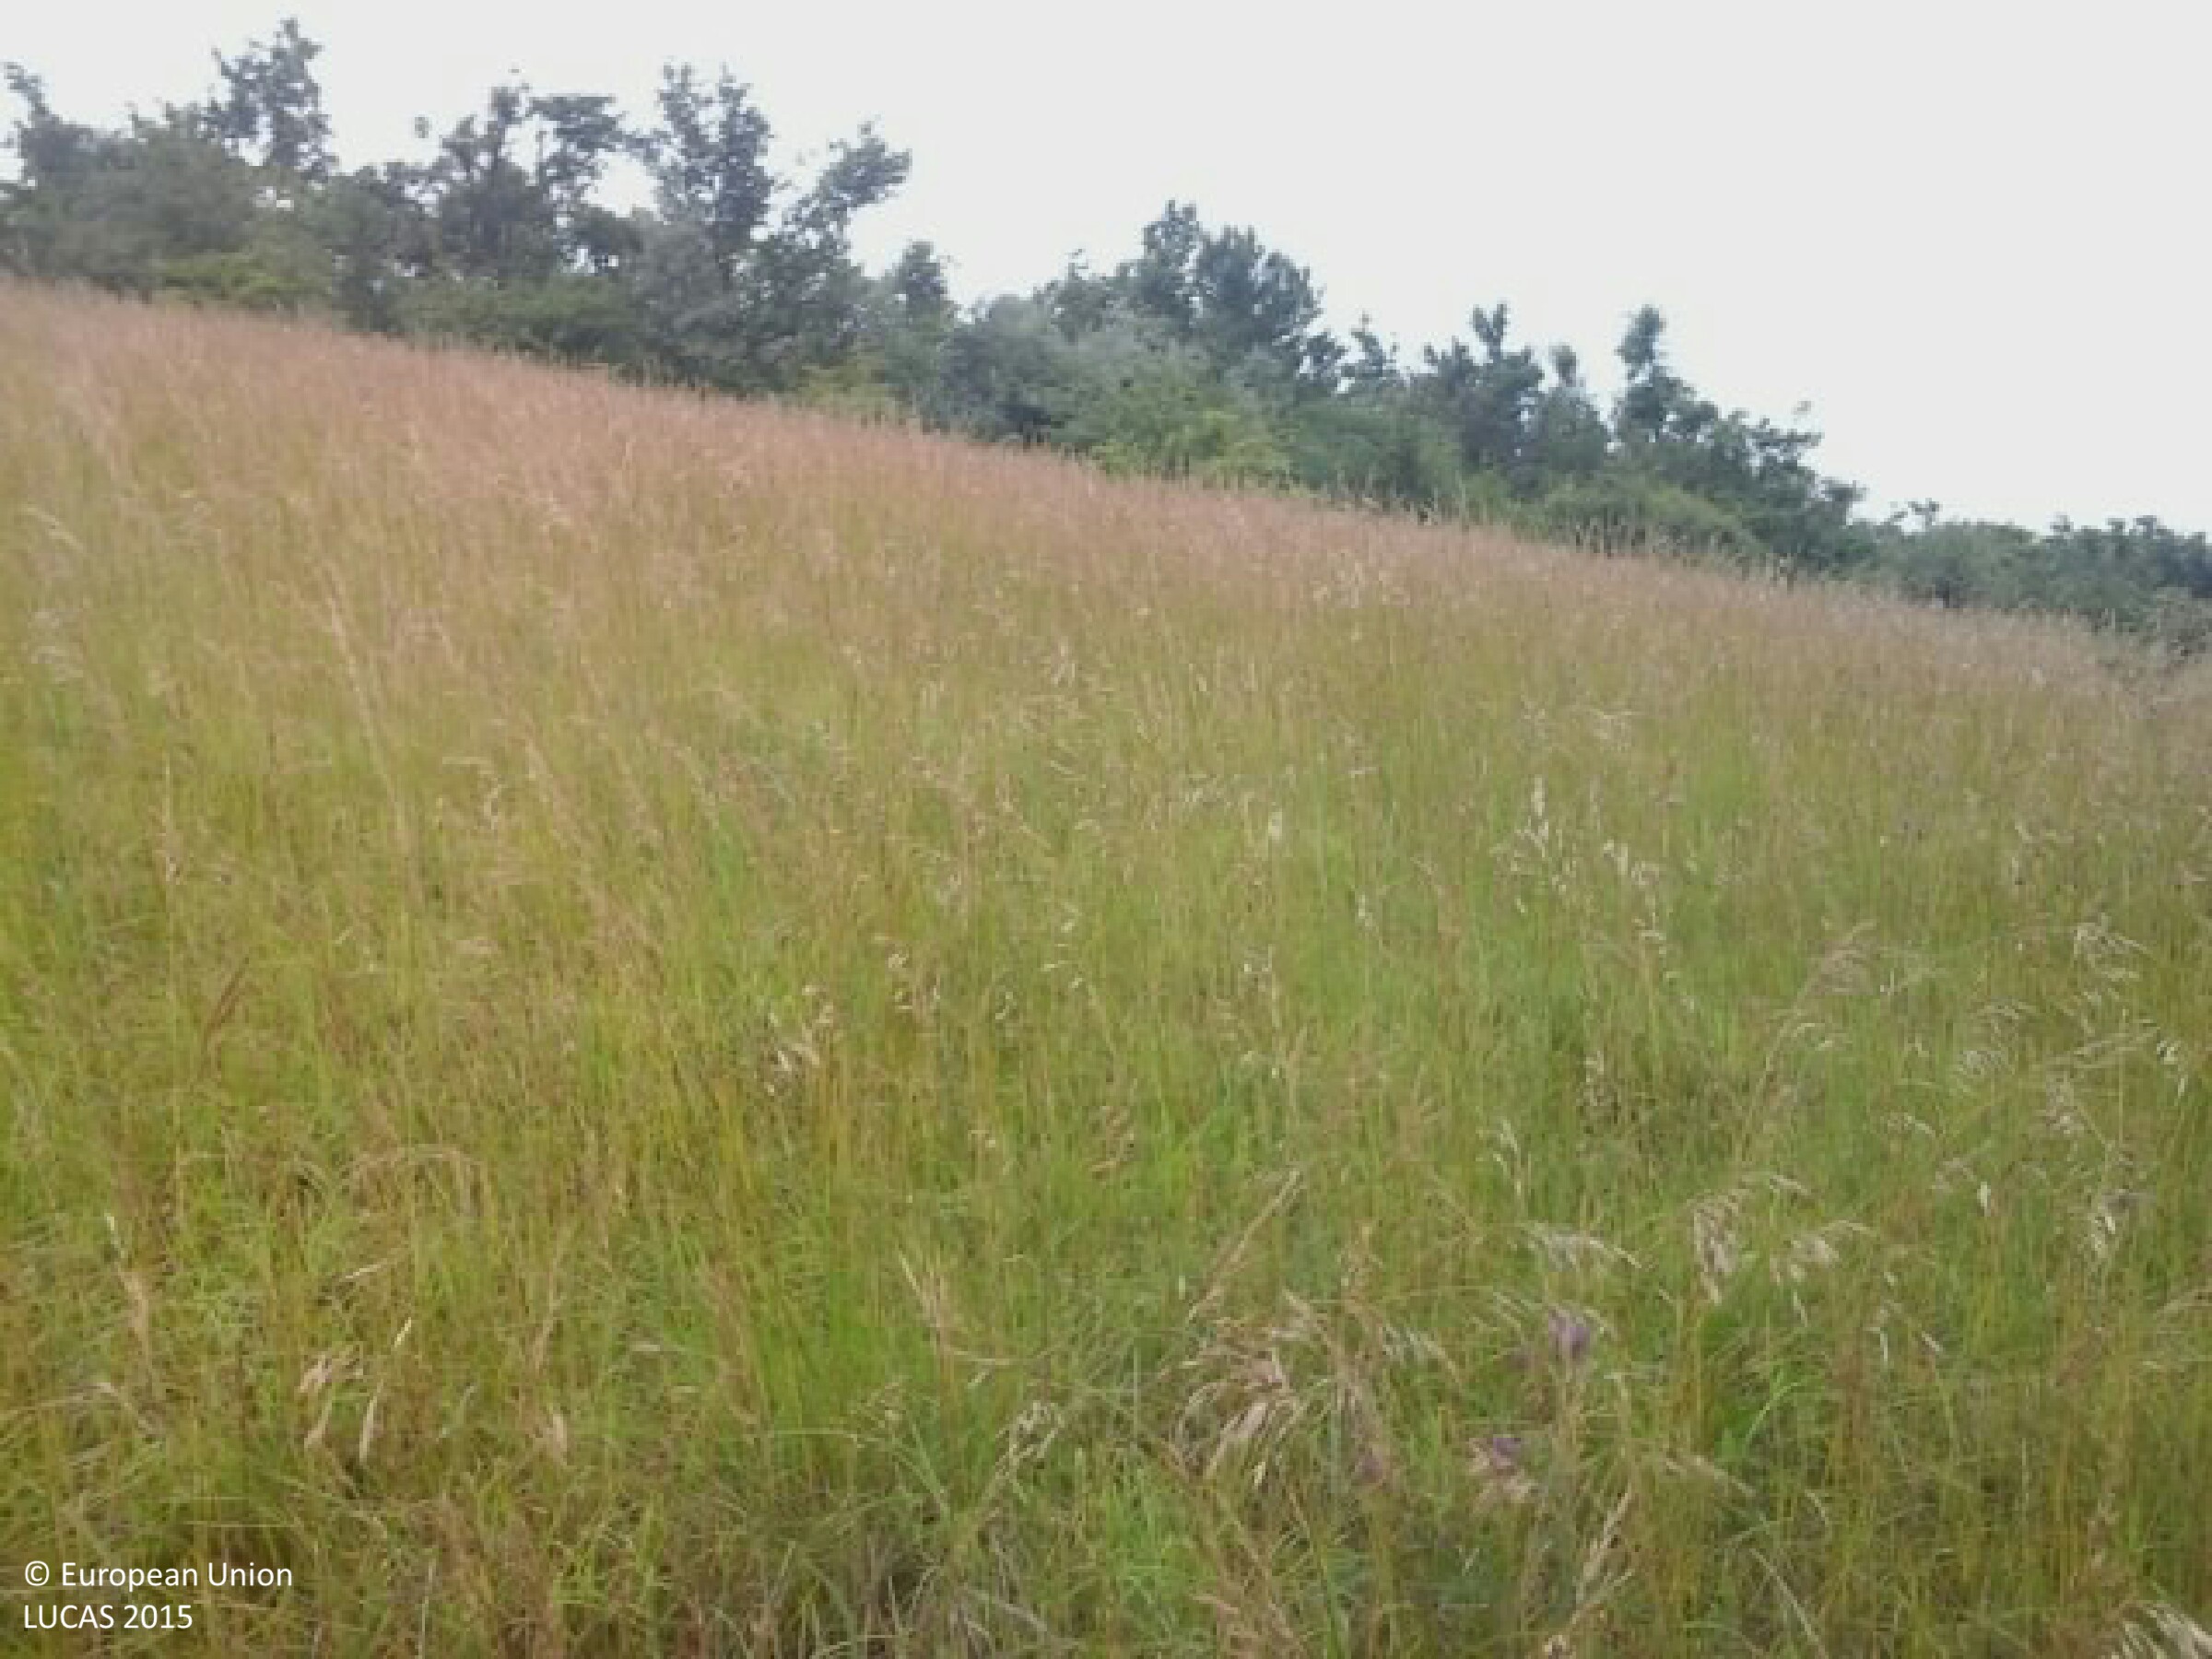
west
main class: Woodland
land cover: Broadleaved woodland
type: mesophytic deciduous forest
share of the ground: 25 - 50 %
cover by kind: herbaceous plants 50 %, broadleaved forest trees 40 %, shrubs 10 %
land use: Semi-natural and natural areas not in use
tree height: > 5 m
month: June
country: HU
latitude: 47.4767
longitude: 19.4020
